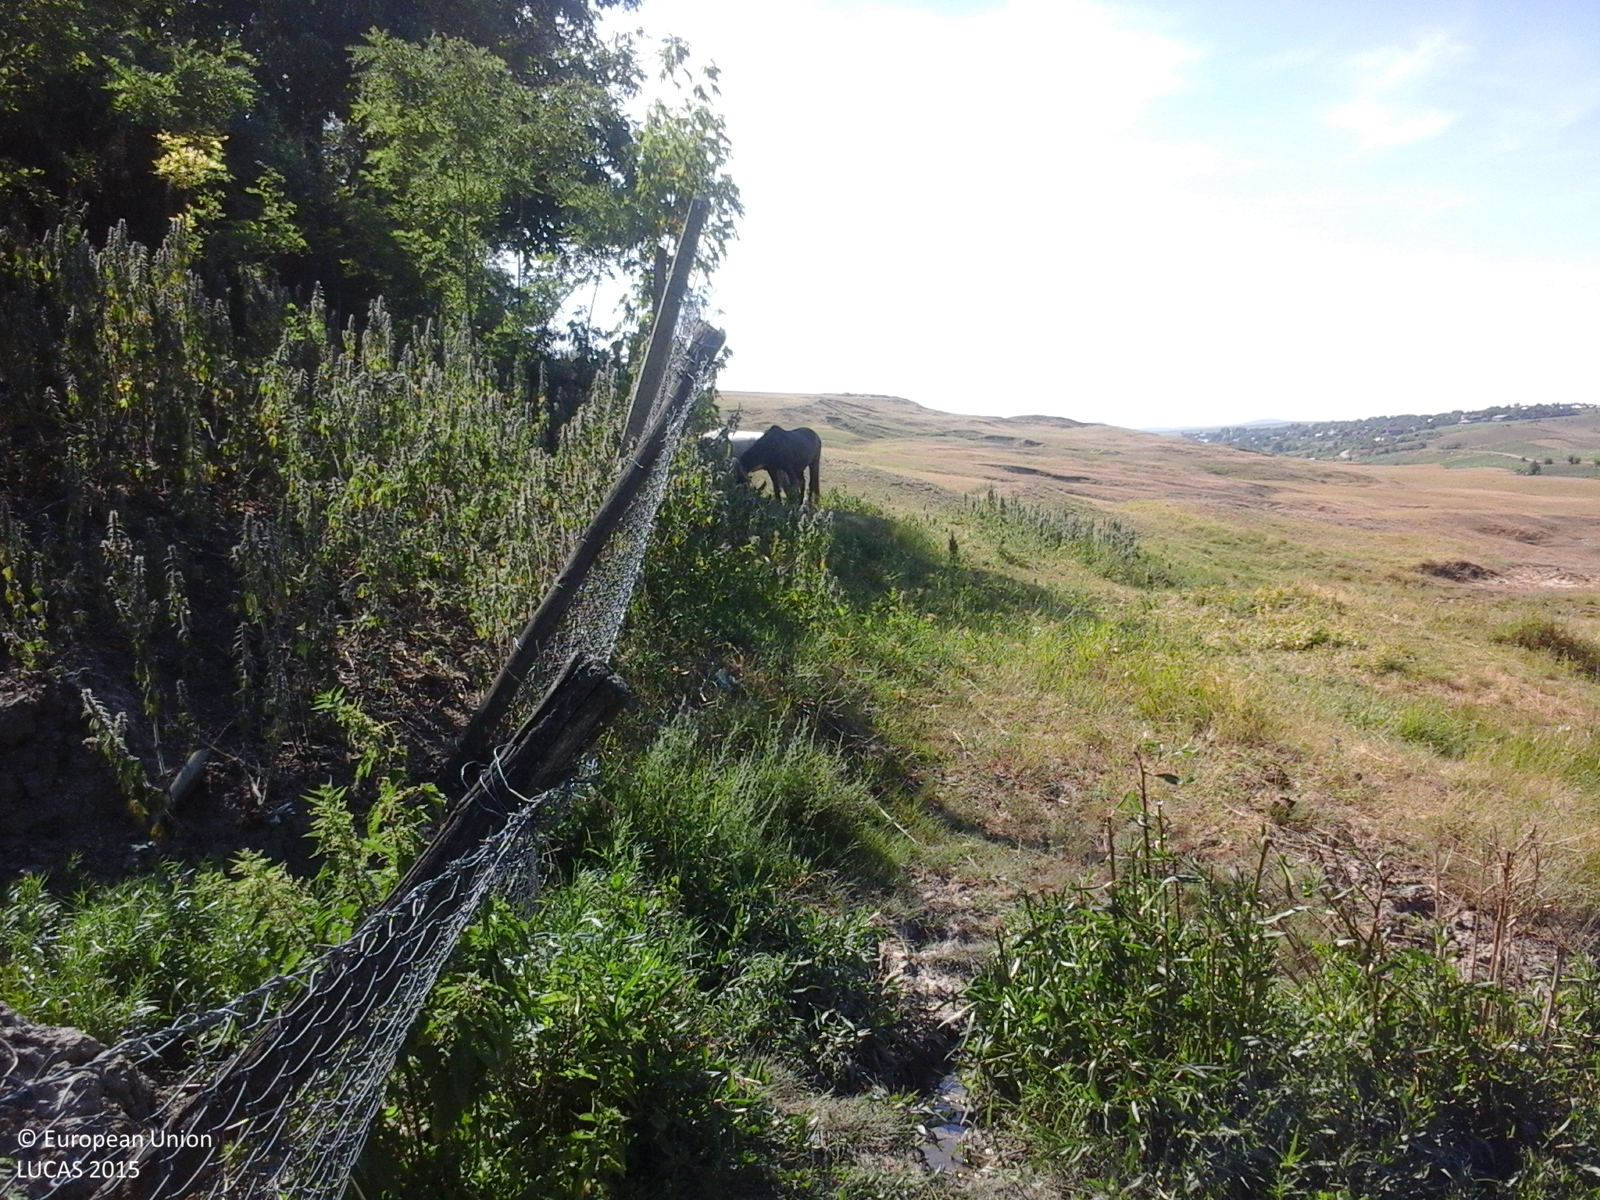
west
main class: Grassland
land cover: Spontaneously vegetated surfaces
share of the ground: > 75 %
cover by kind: herbaceous plants 100 %
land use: Agriculture (excluding fallow land and kitchen gardens)
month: June
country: RO
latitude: 47.2841
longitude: 27.0664
